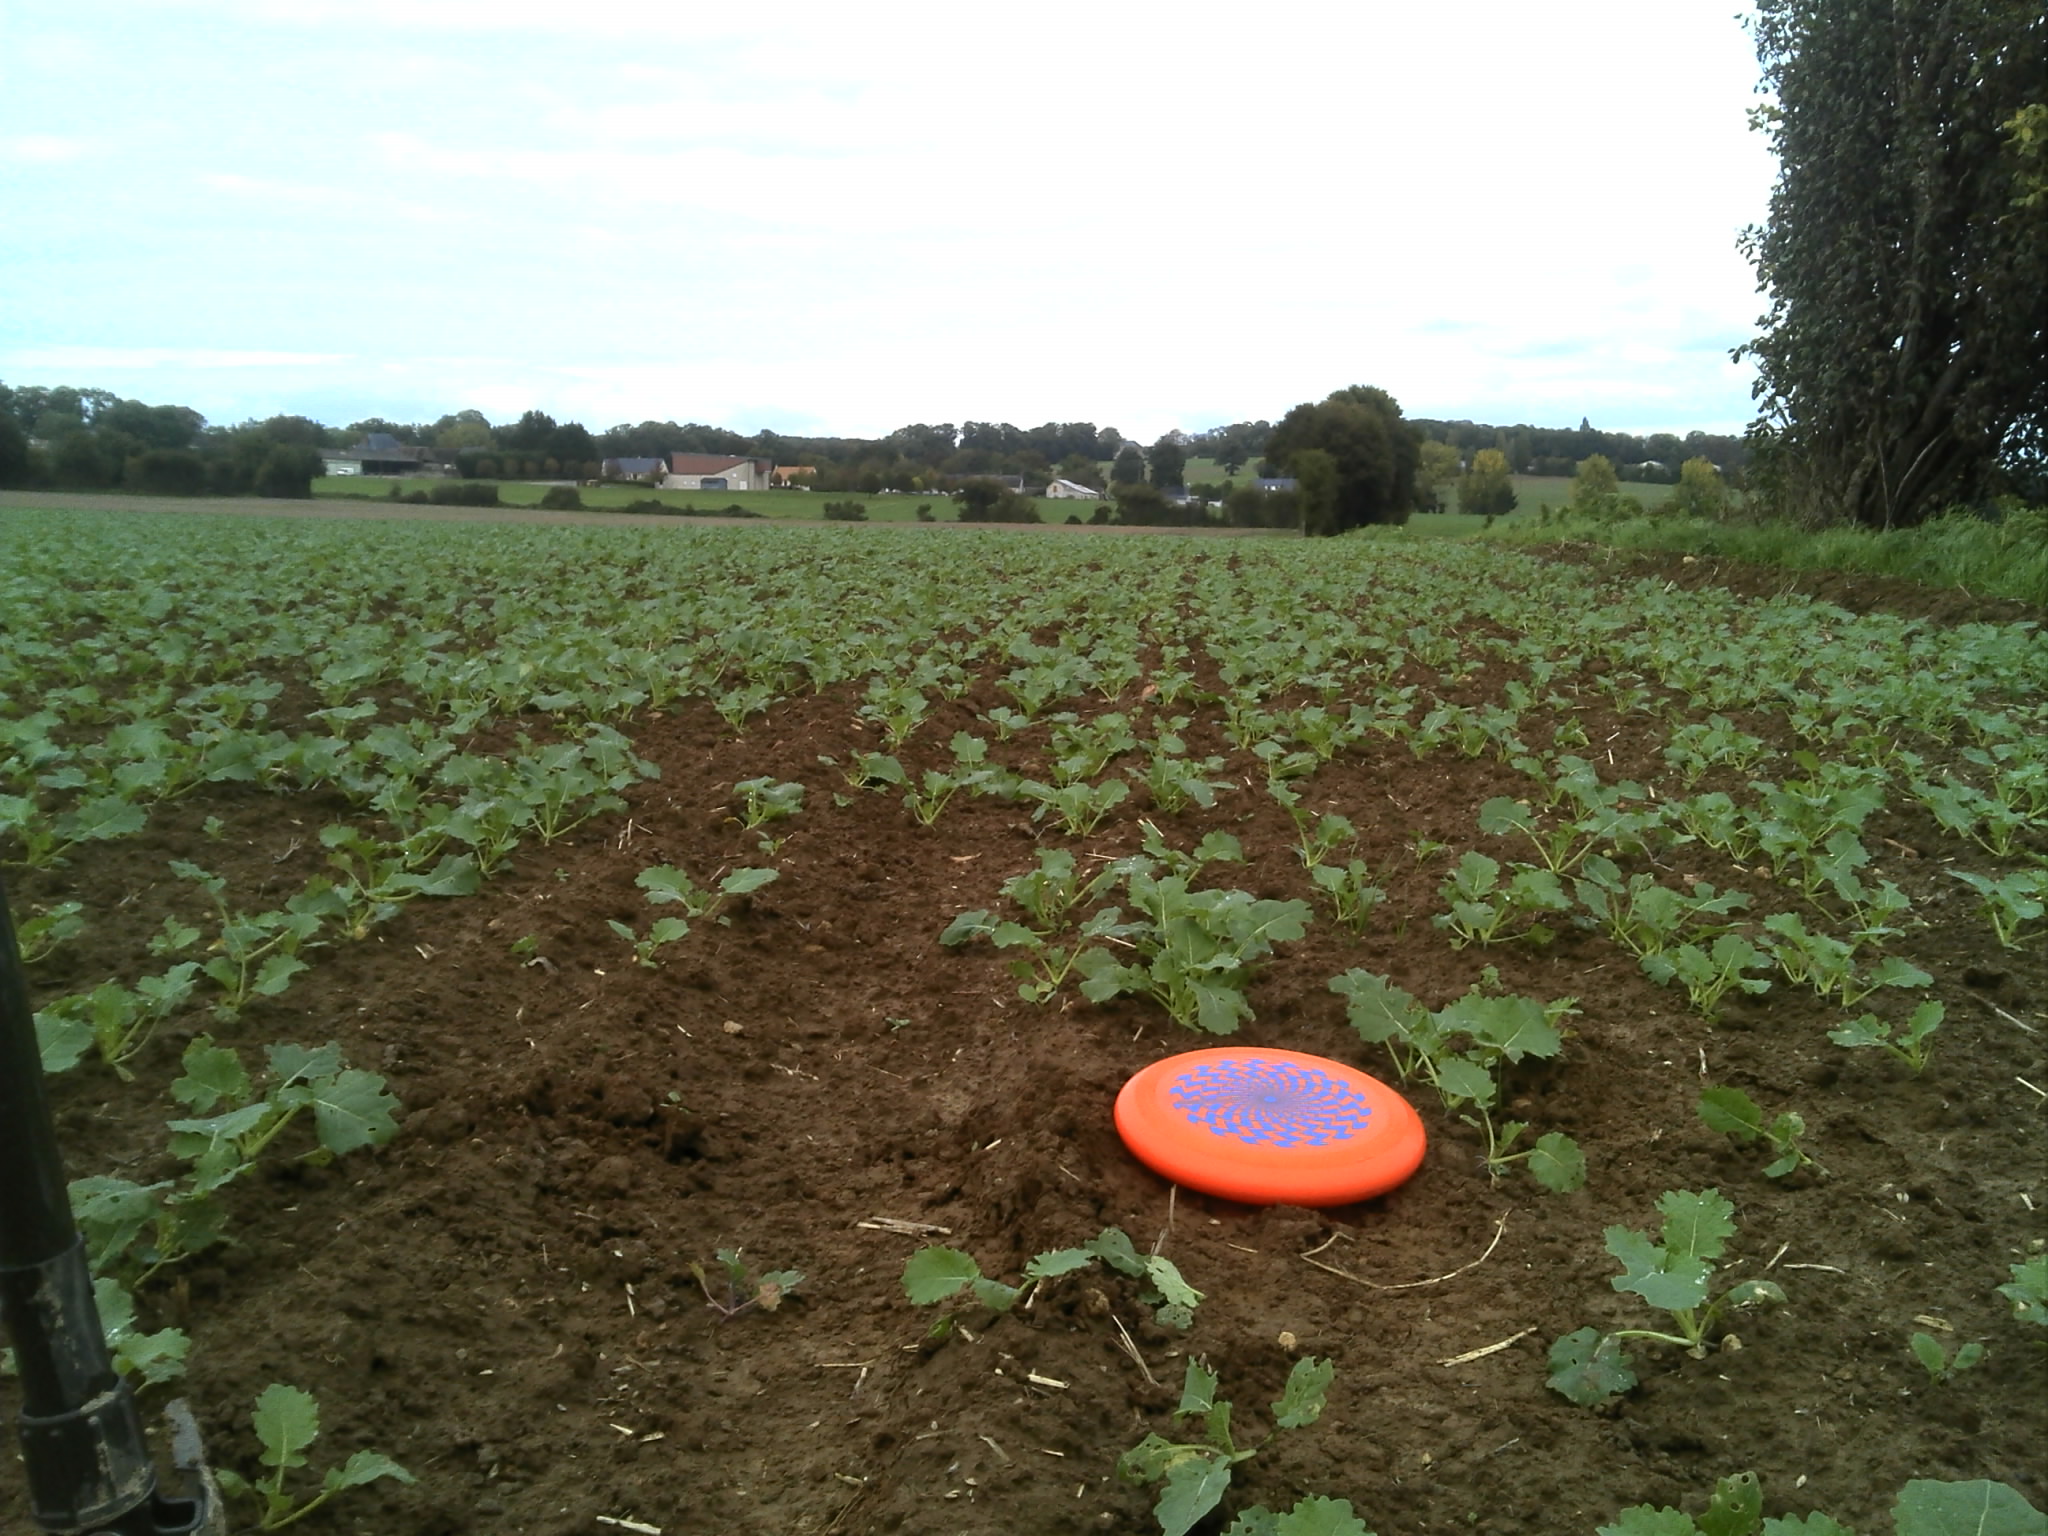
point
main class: Cropland
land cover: Rape and turnip rape
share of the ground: 50 - 75 %
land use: Agriculture (excluding fallow land and kitchen gardens)
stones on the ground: 10 - 25 %
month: October
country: FR
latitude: 48.0661
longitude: -0.1074
